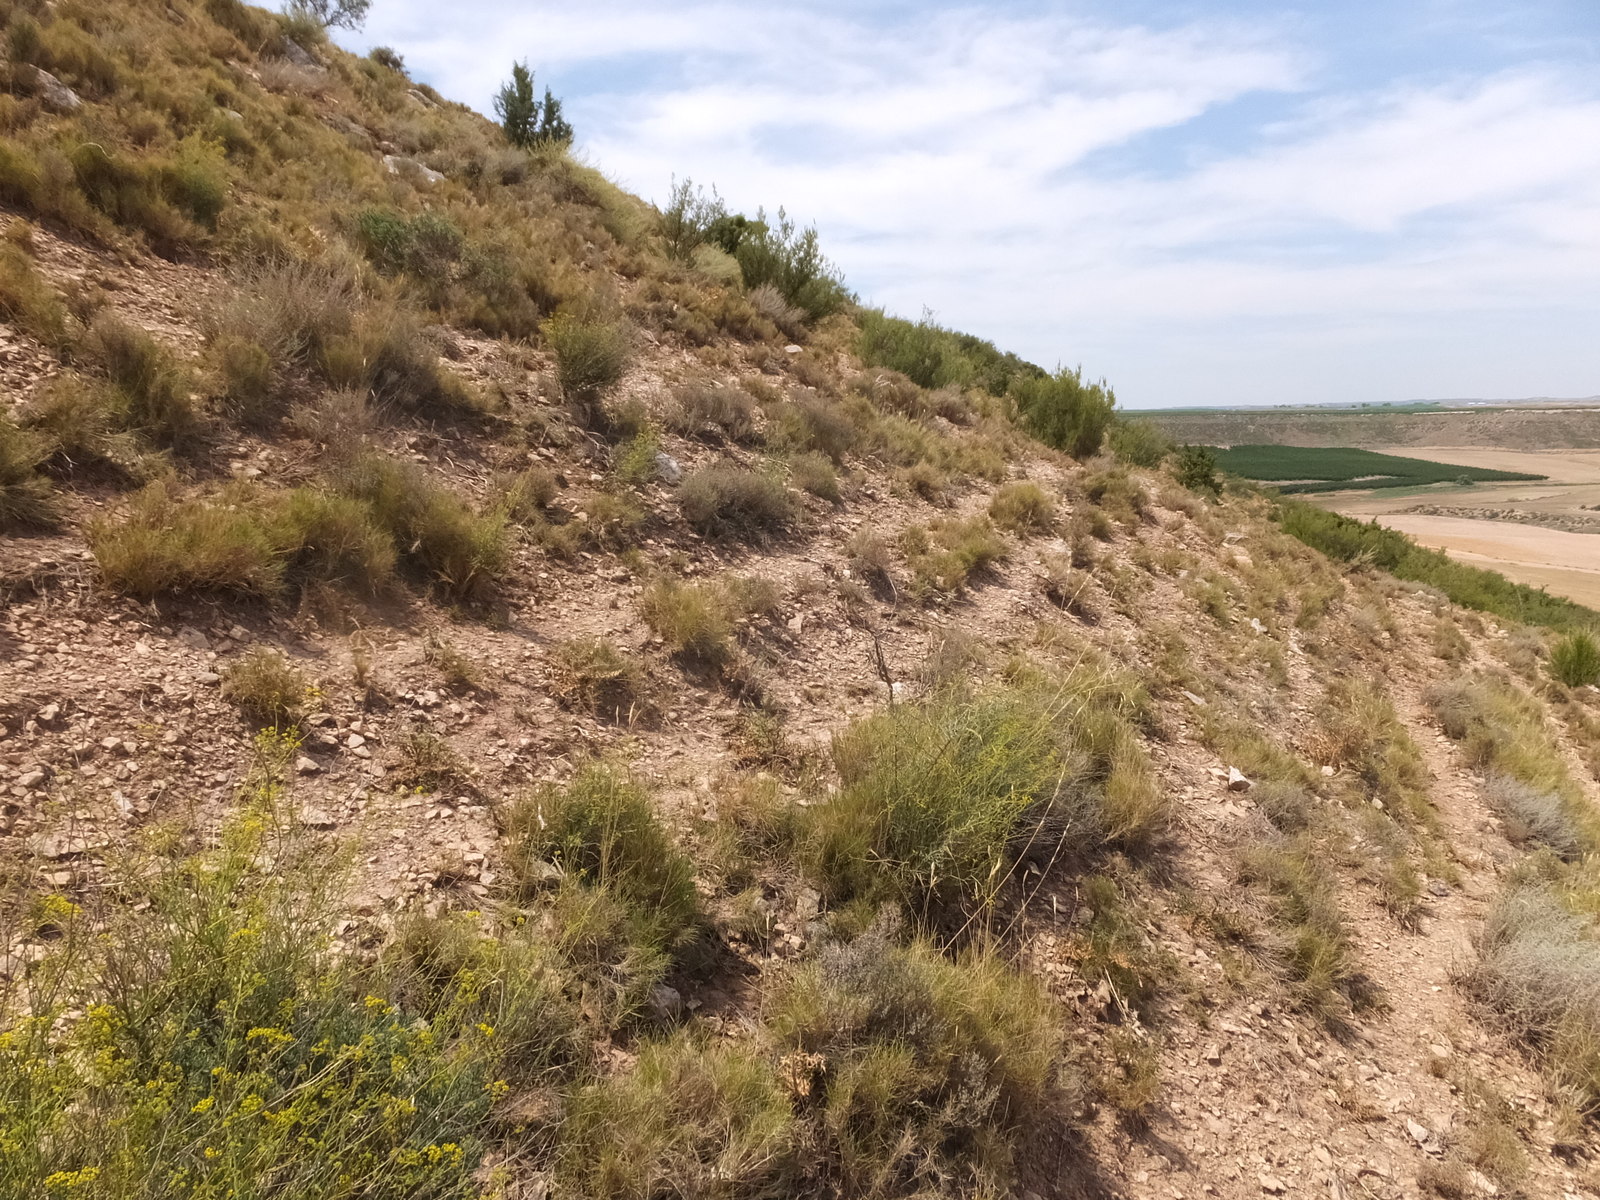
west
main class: Shrubland
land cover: Shrubland without tree cover
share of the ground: > 75 %
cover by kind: shrubs 70 %, herbaceous plants 20 %, consolidated bare surface 10 %
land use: Semi-natural and natural areas not in use
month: August
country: ES
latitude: 41.4821
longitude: 0.1540
